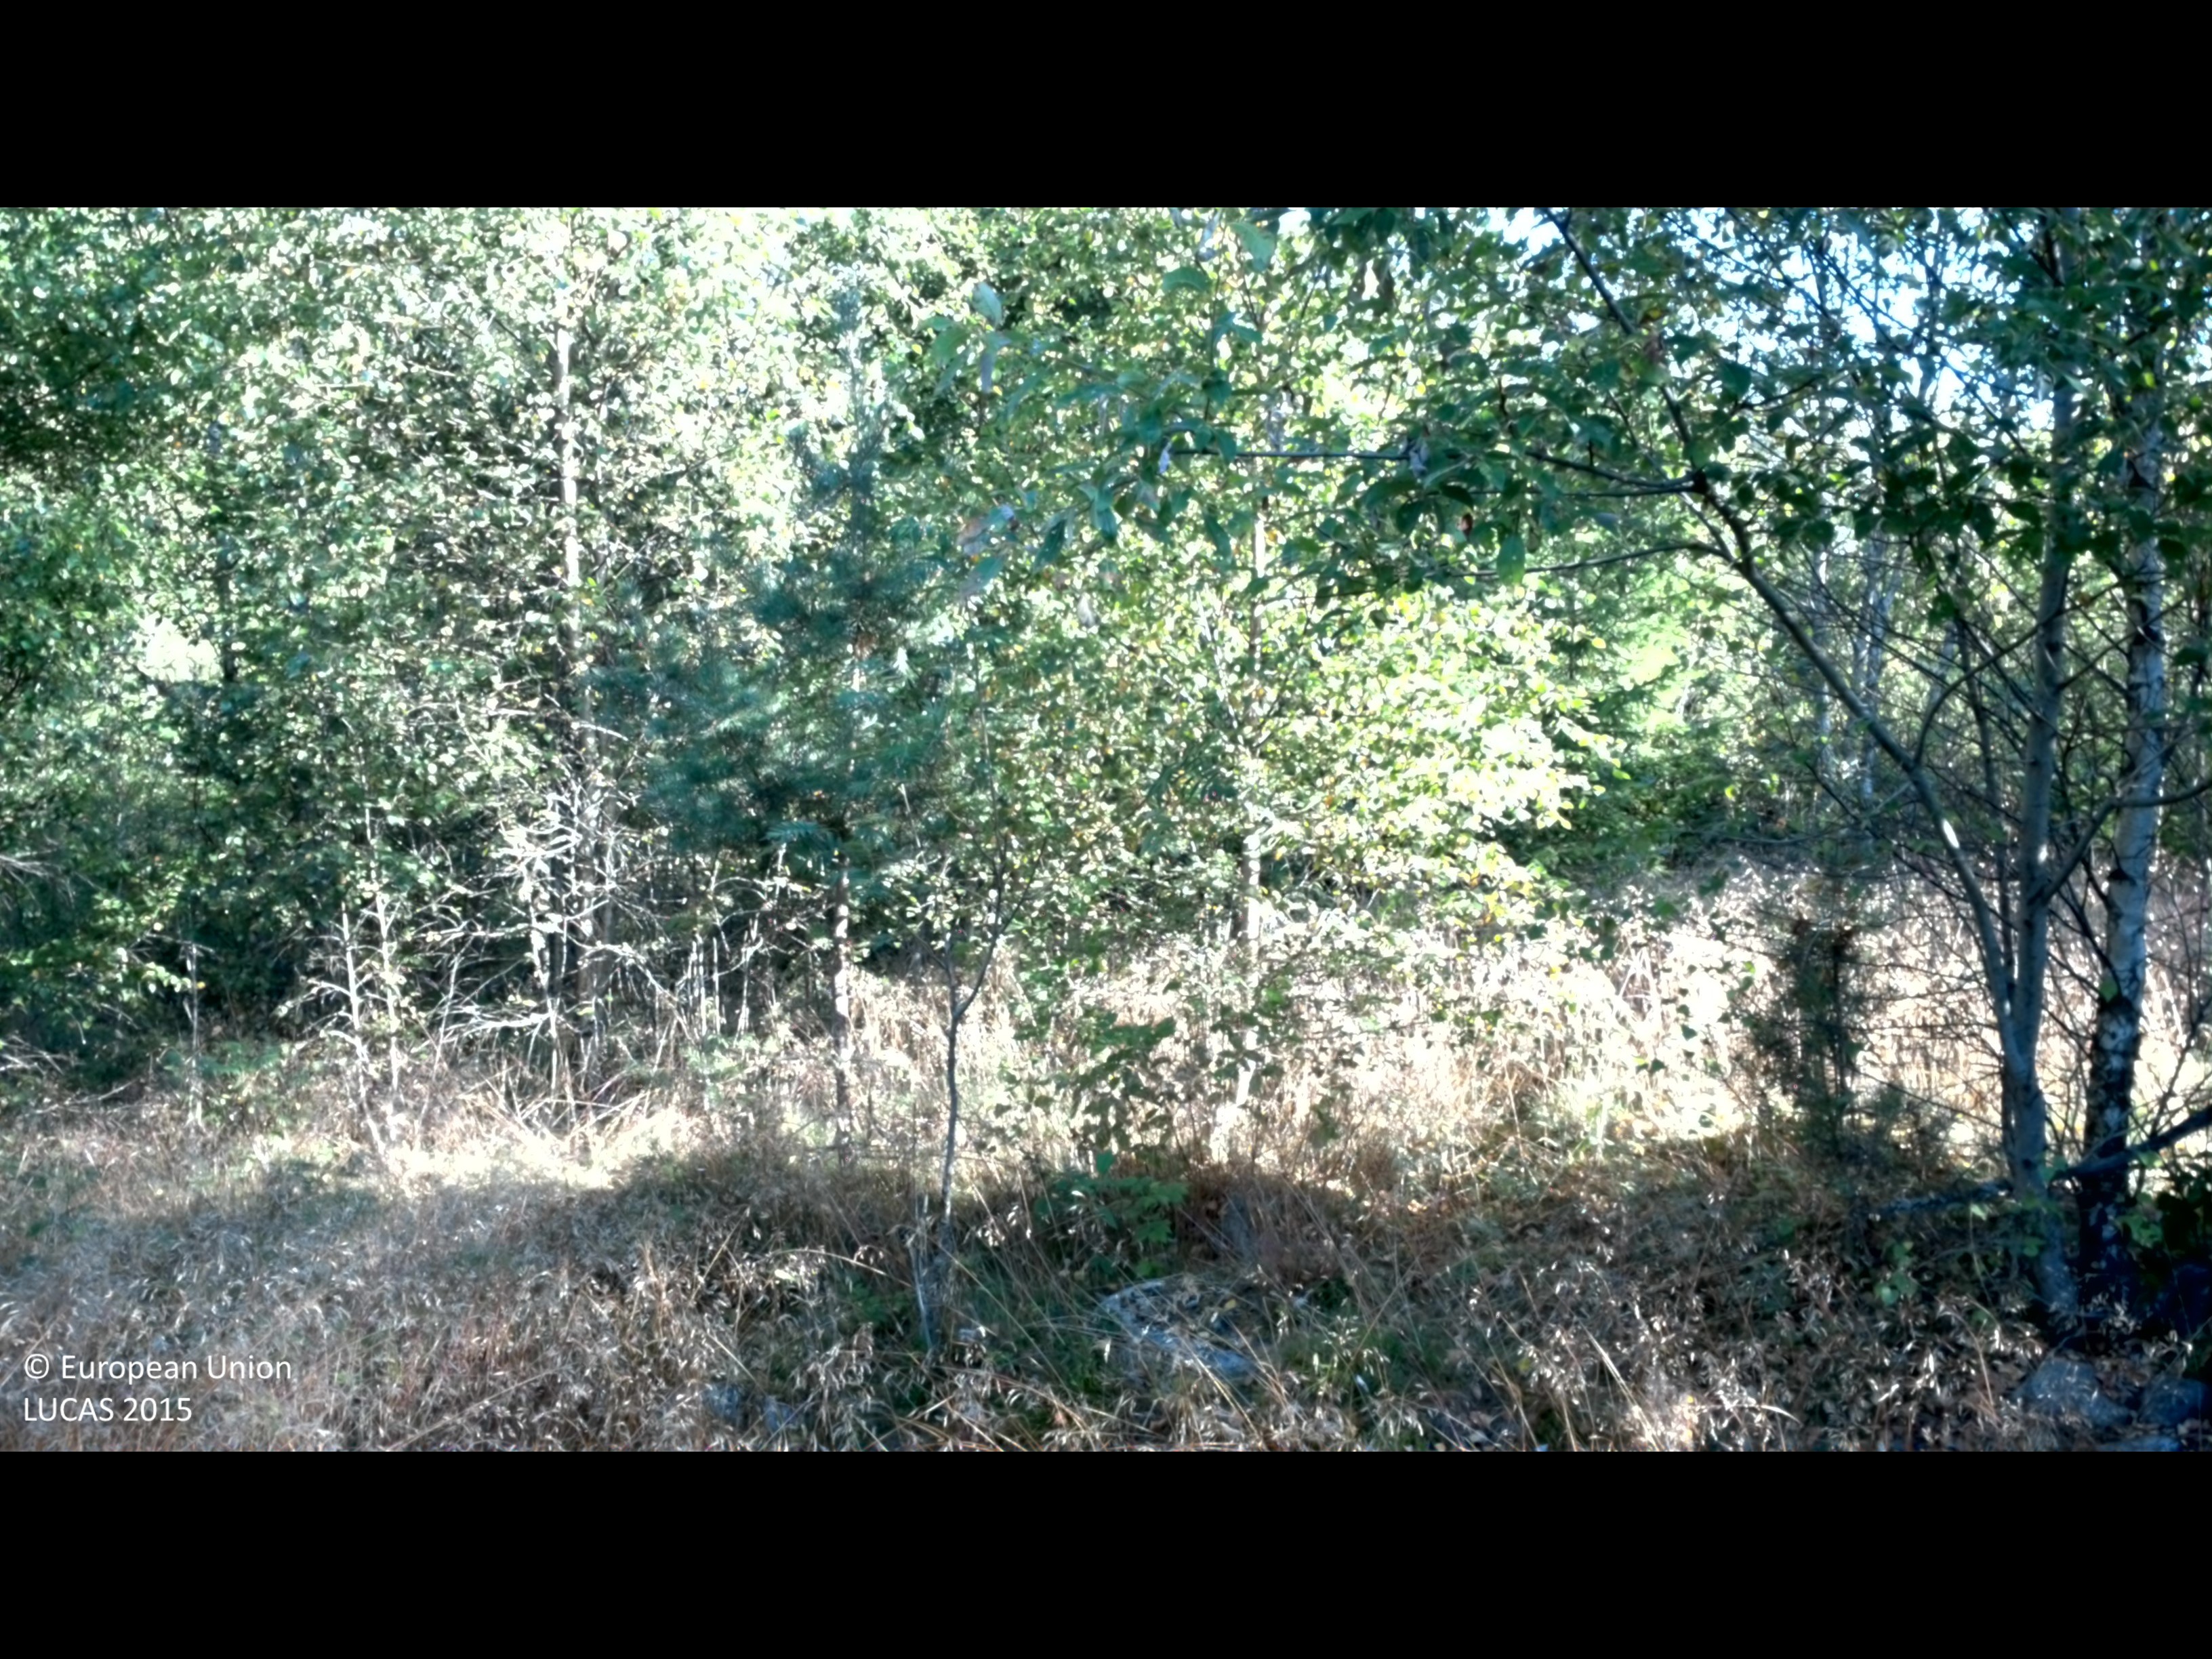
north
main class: Woodland
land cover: Spruce dominated mixed woodland
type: boreal forest
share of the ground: 50 - 75 %
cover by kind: broadleaved forest trees 40 %, coniferous forest trees 30 %, herbaceous plants 25 %, shrubs 5 %
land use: Forestry
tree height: > 5 m
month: August
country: SE
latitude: 56.9297
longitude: 14.1866
